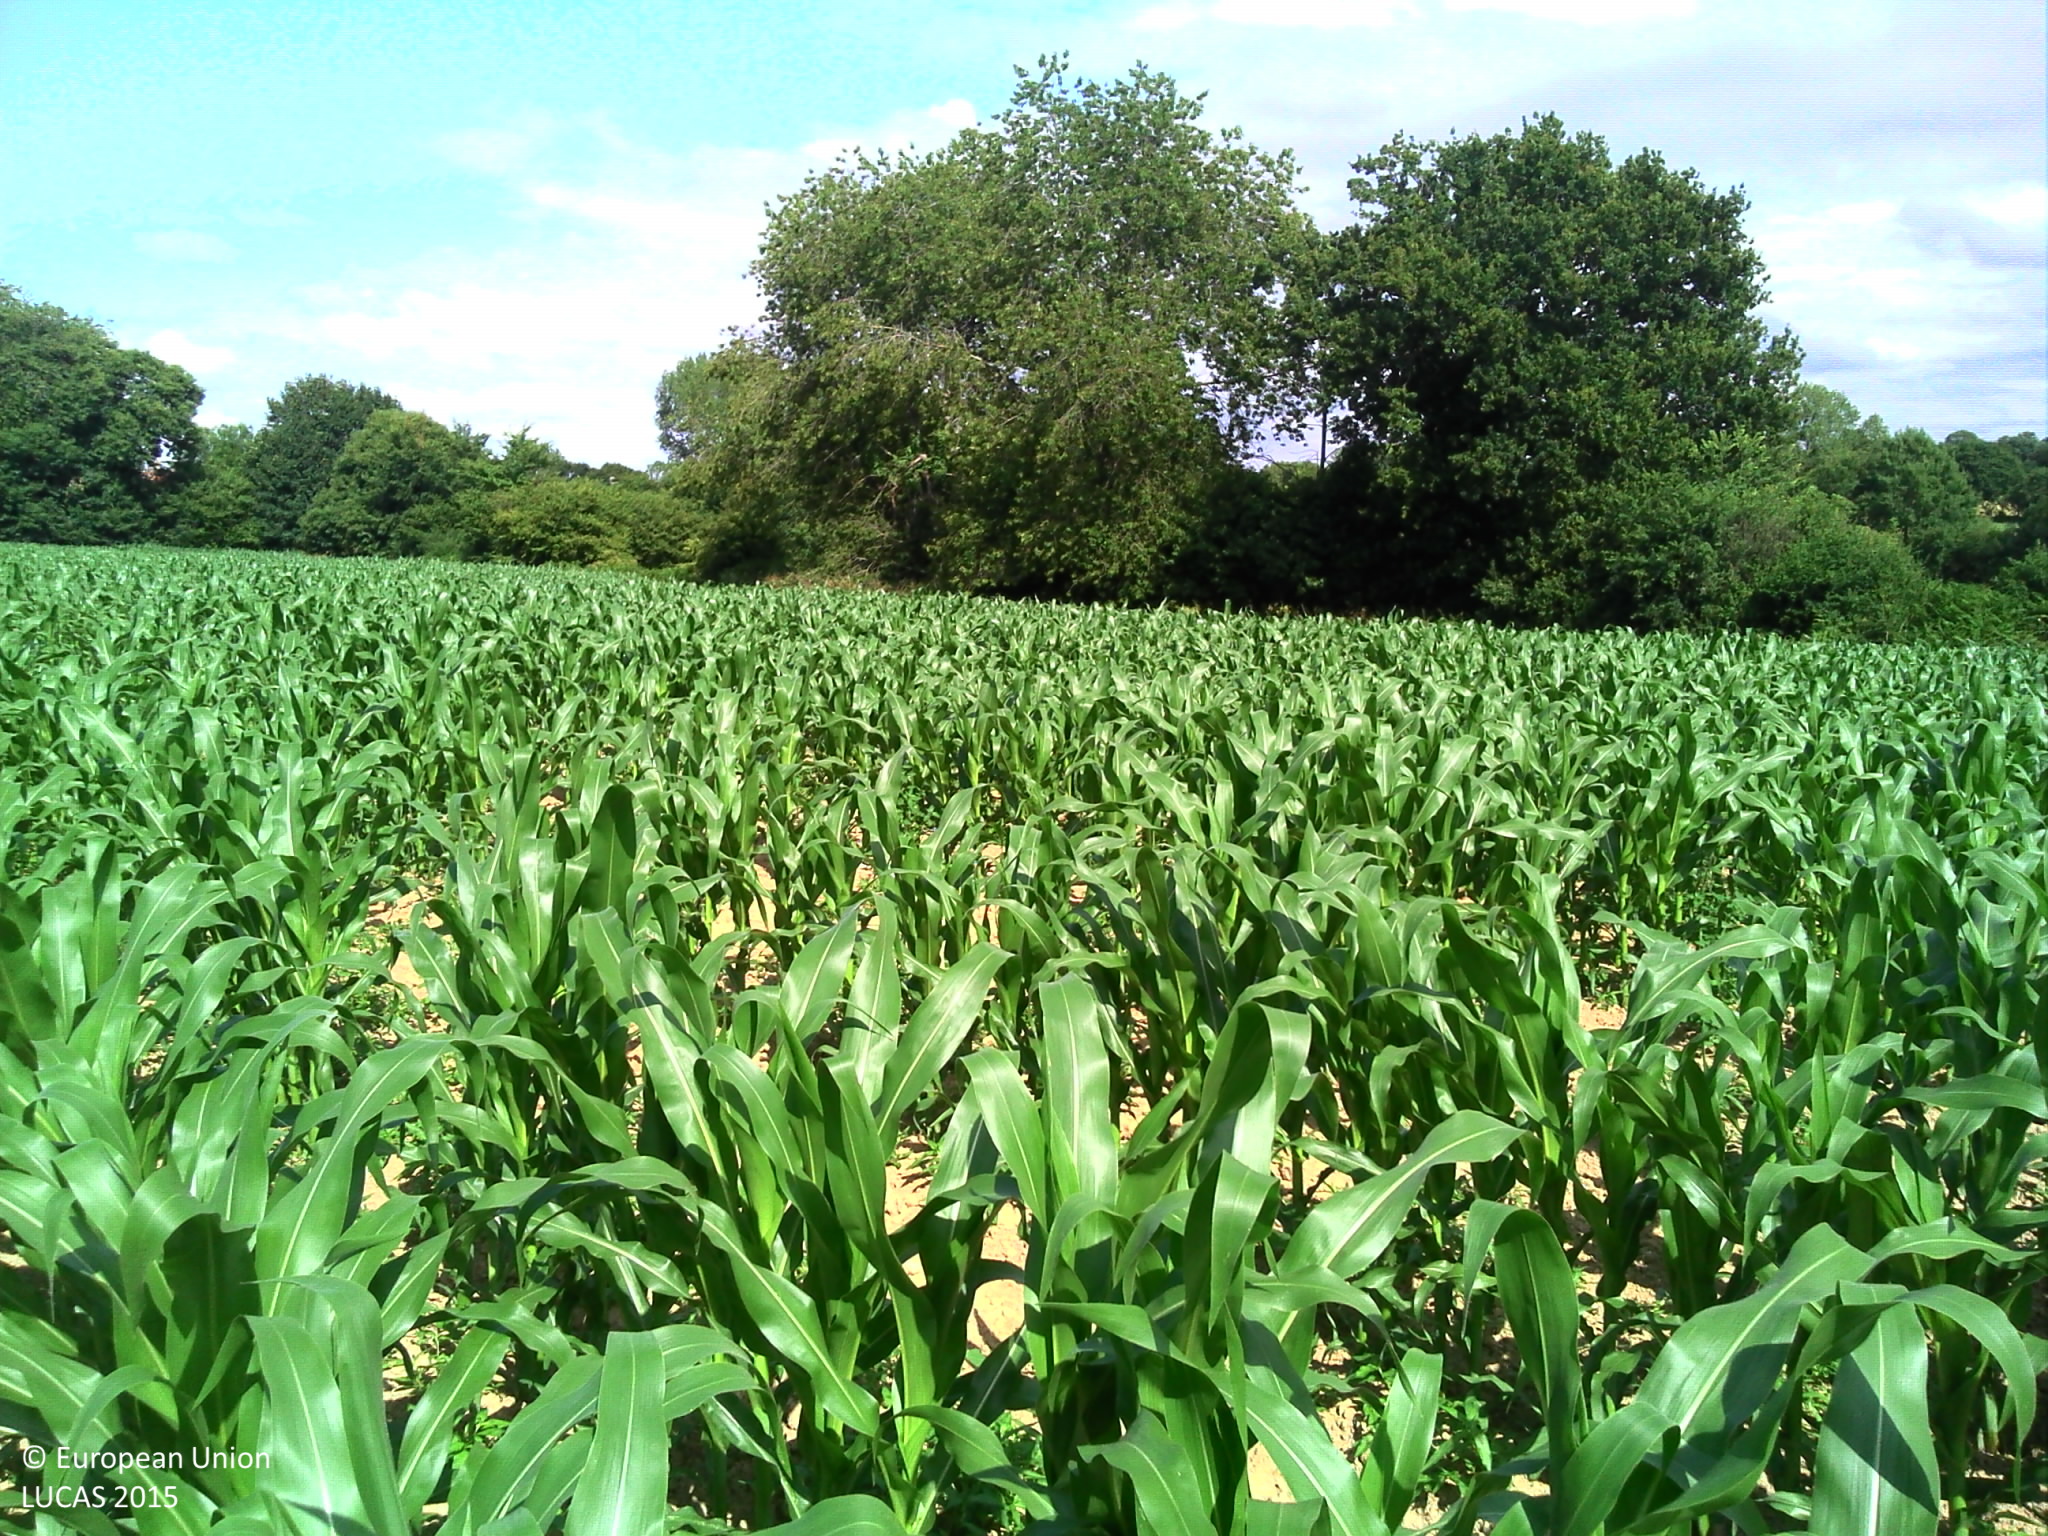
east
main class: Cropland
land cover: Maize
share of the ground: 50 - 75 %
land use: Agriculture (excluding fallow land and kitchen gardens)
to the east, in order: Maize; Broadleaved woodland; Grassland without tree/shrub cover; Broadleaved woodland; Grassland without tree/shrub cover; Managed hedges; Grassland without tree/shrub cover; Managed hedges; Grassland with sparse tree/shrub cover
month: July
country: FR
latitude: 48.9540
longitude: -1.4229
